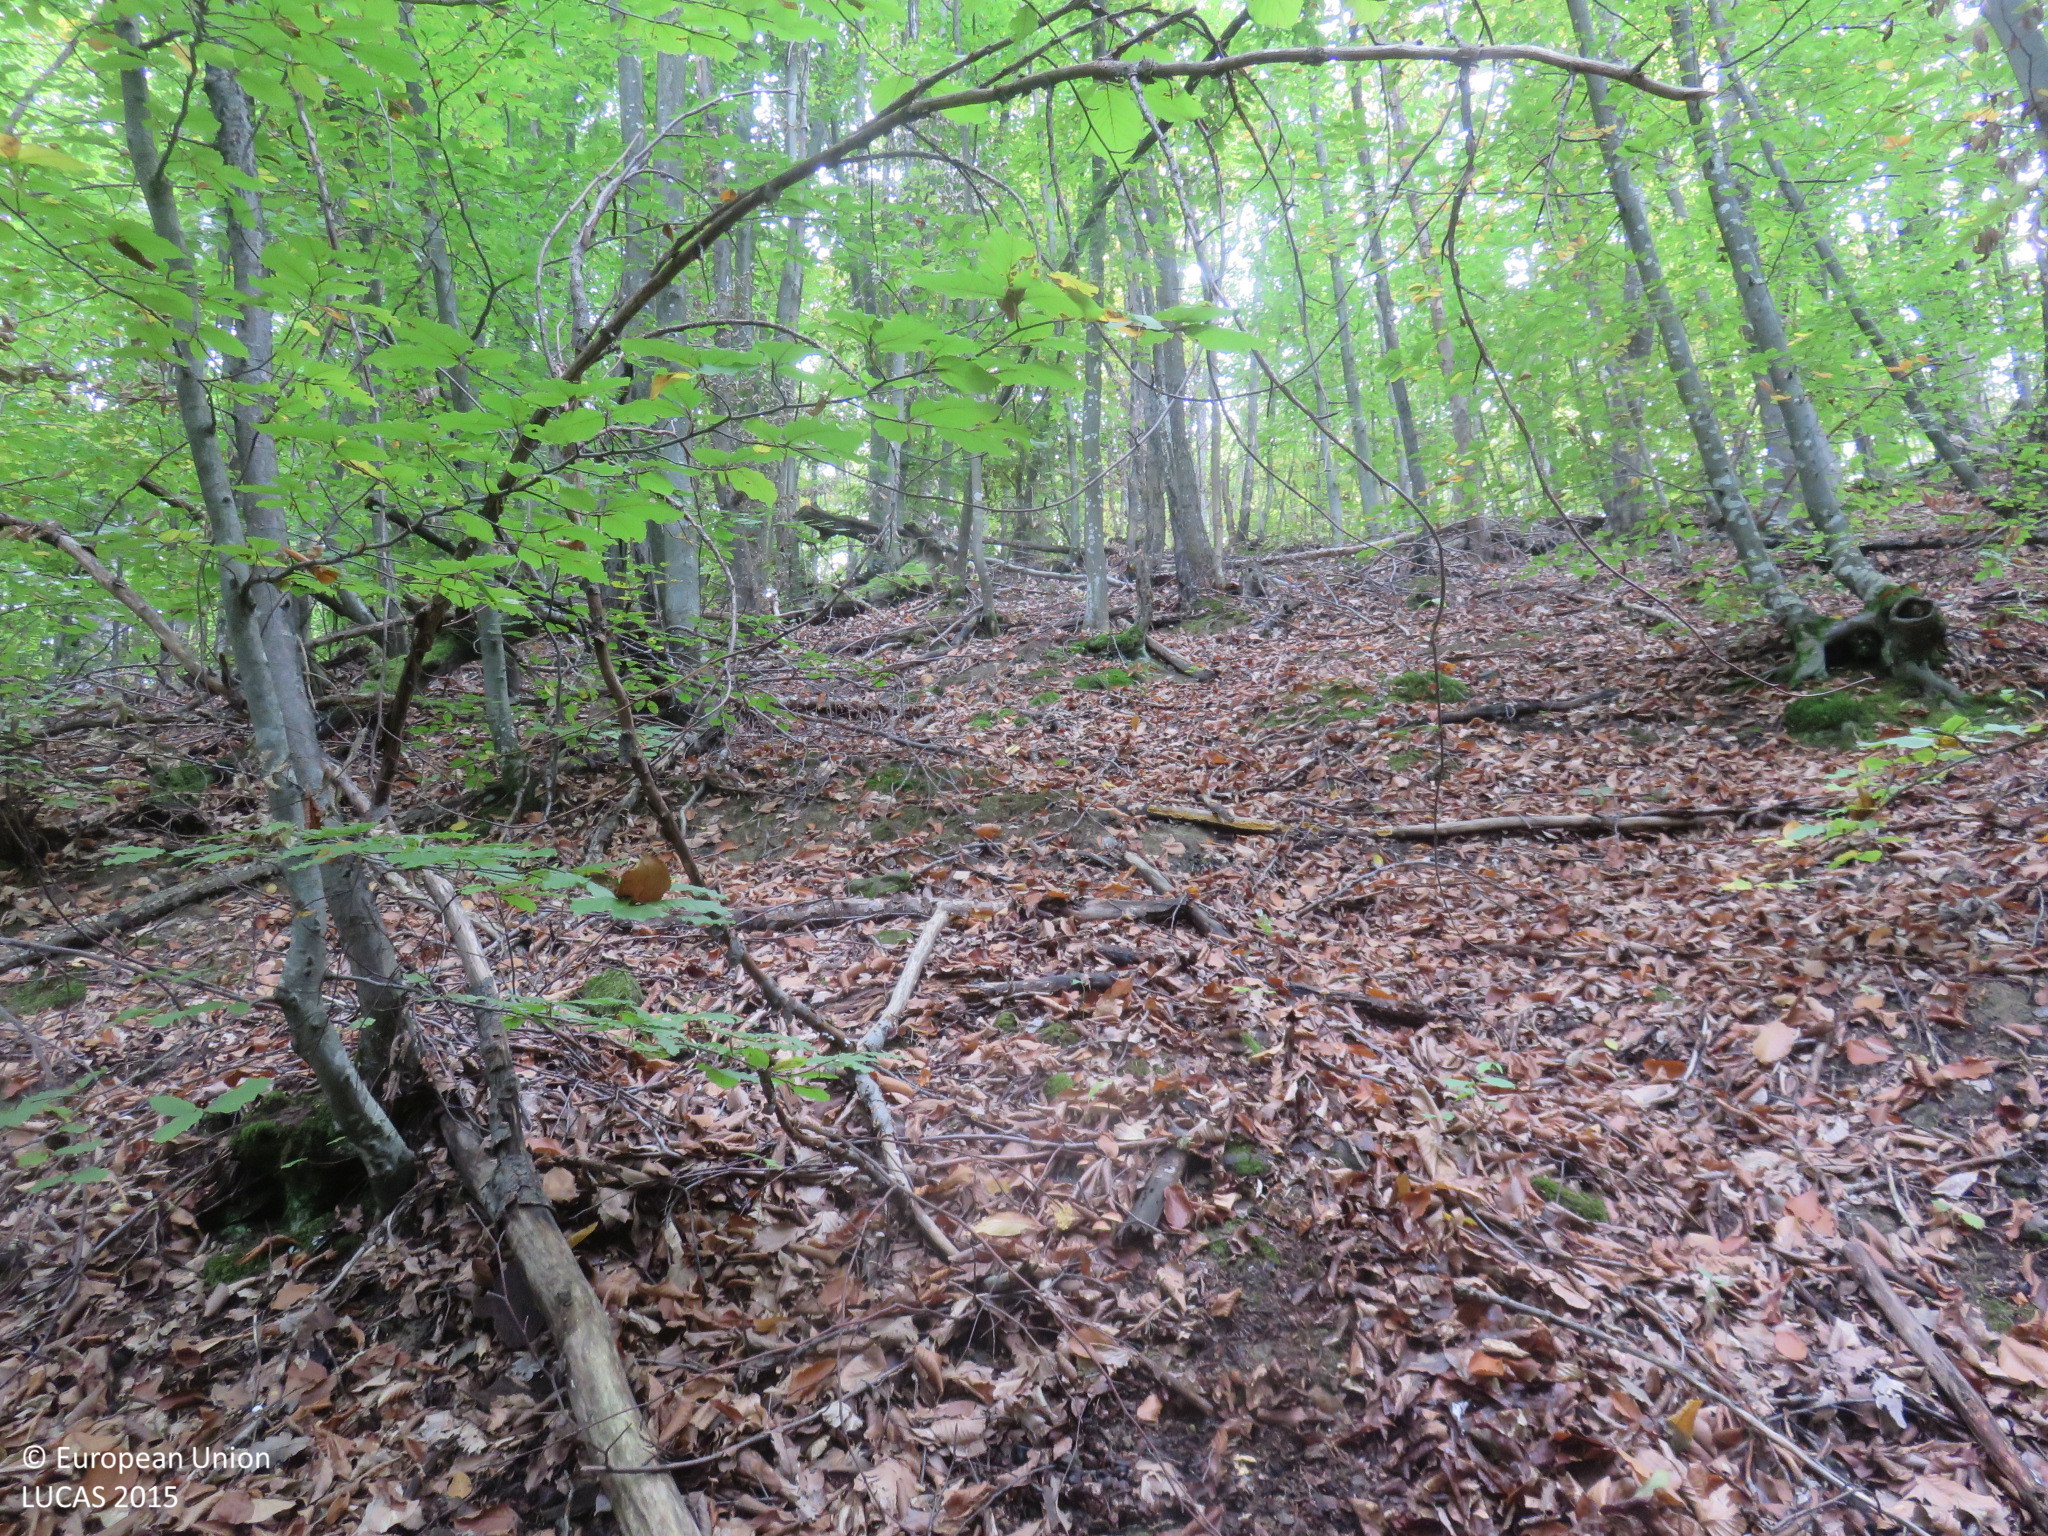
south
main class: Woodland
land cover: Broadleaved woodland
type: beech forest
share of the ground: > 75 %
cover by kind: broadleaved forest trees 85 %, unconsolidated bare surface 10 %, shrubs 5 %
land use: Forestry
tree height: > 5 m
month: October
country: BG
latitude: 42.9090
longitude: 24.9709
